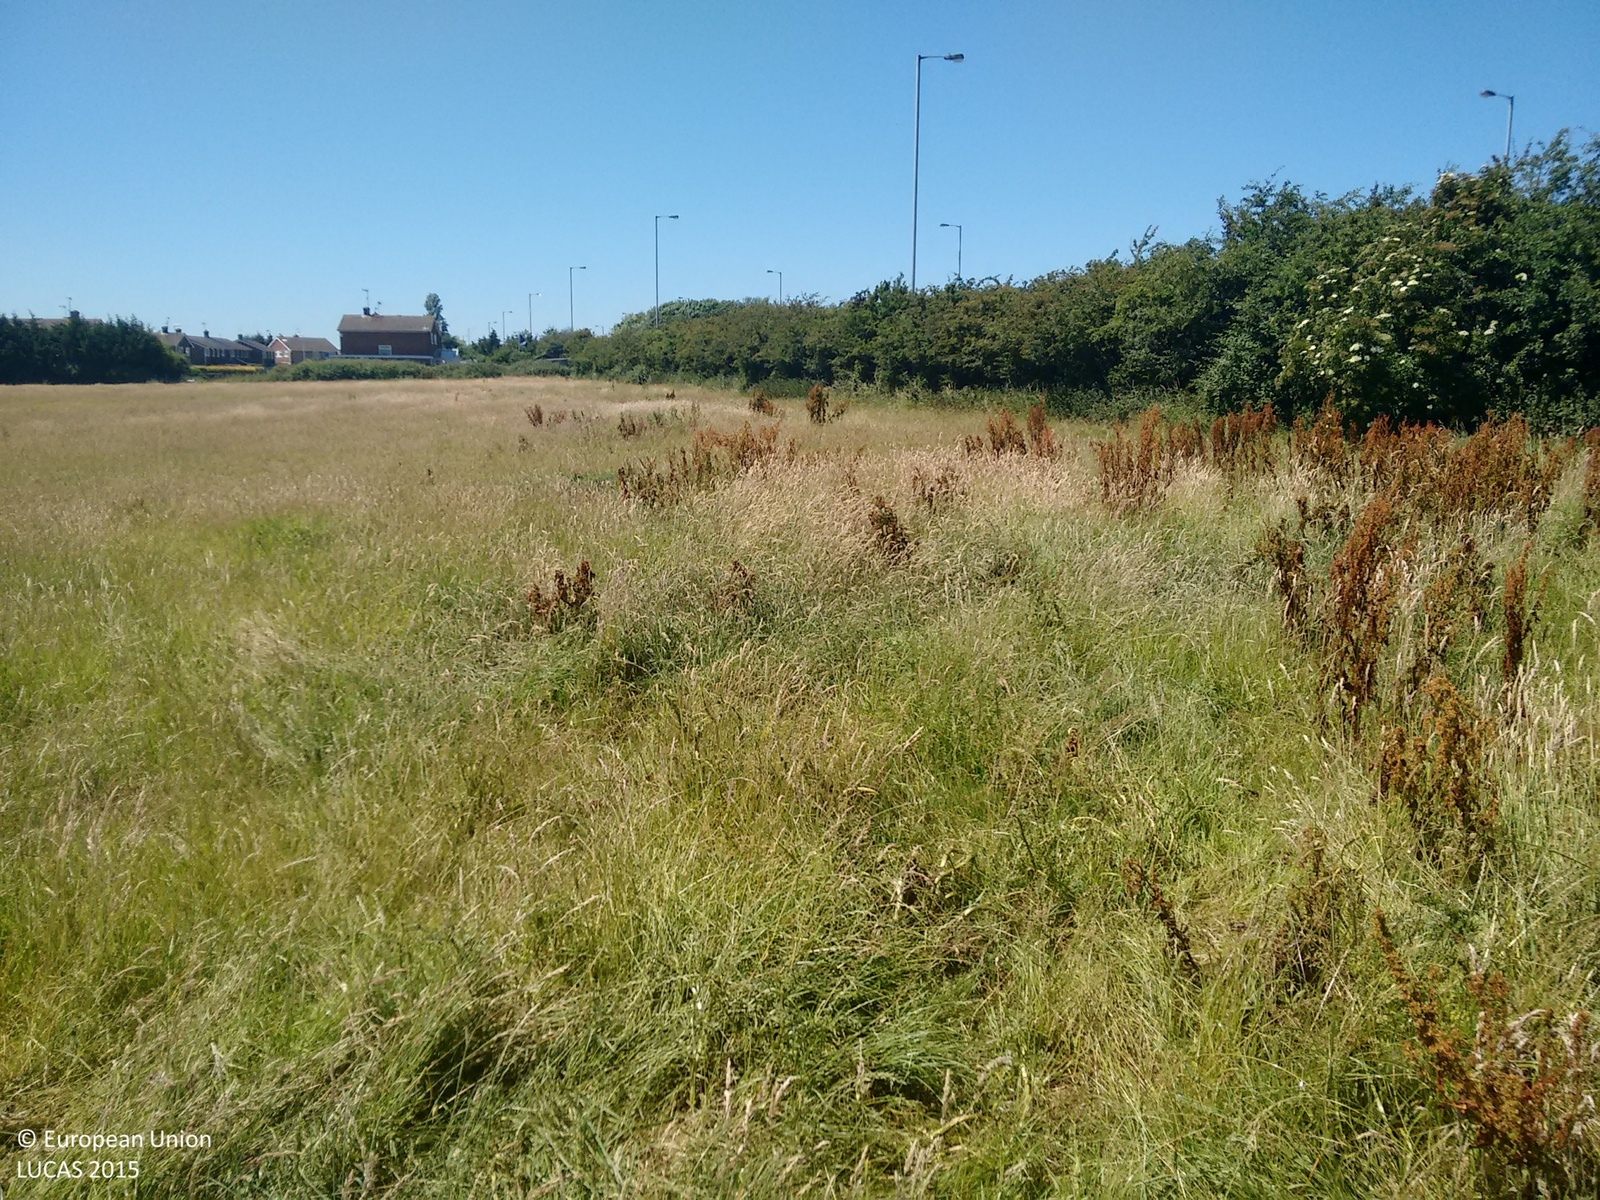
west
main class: Grassland
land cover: Grassland without tree/shrub cover
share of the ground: > 75 %
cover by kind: herbaceous plants 100 %
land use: Agriculture (excluding fallow land and kitchen gardens)
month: June
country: GB
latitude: 50.8352
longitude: -0.3595
